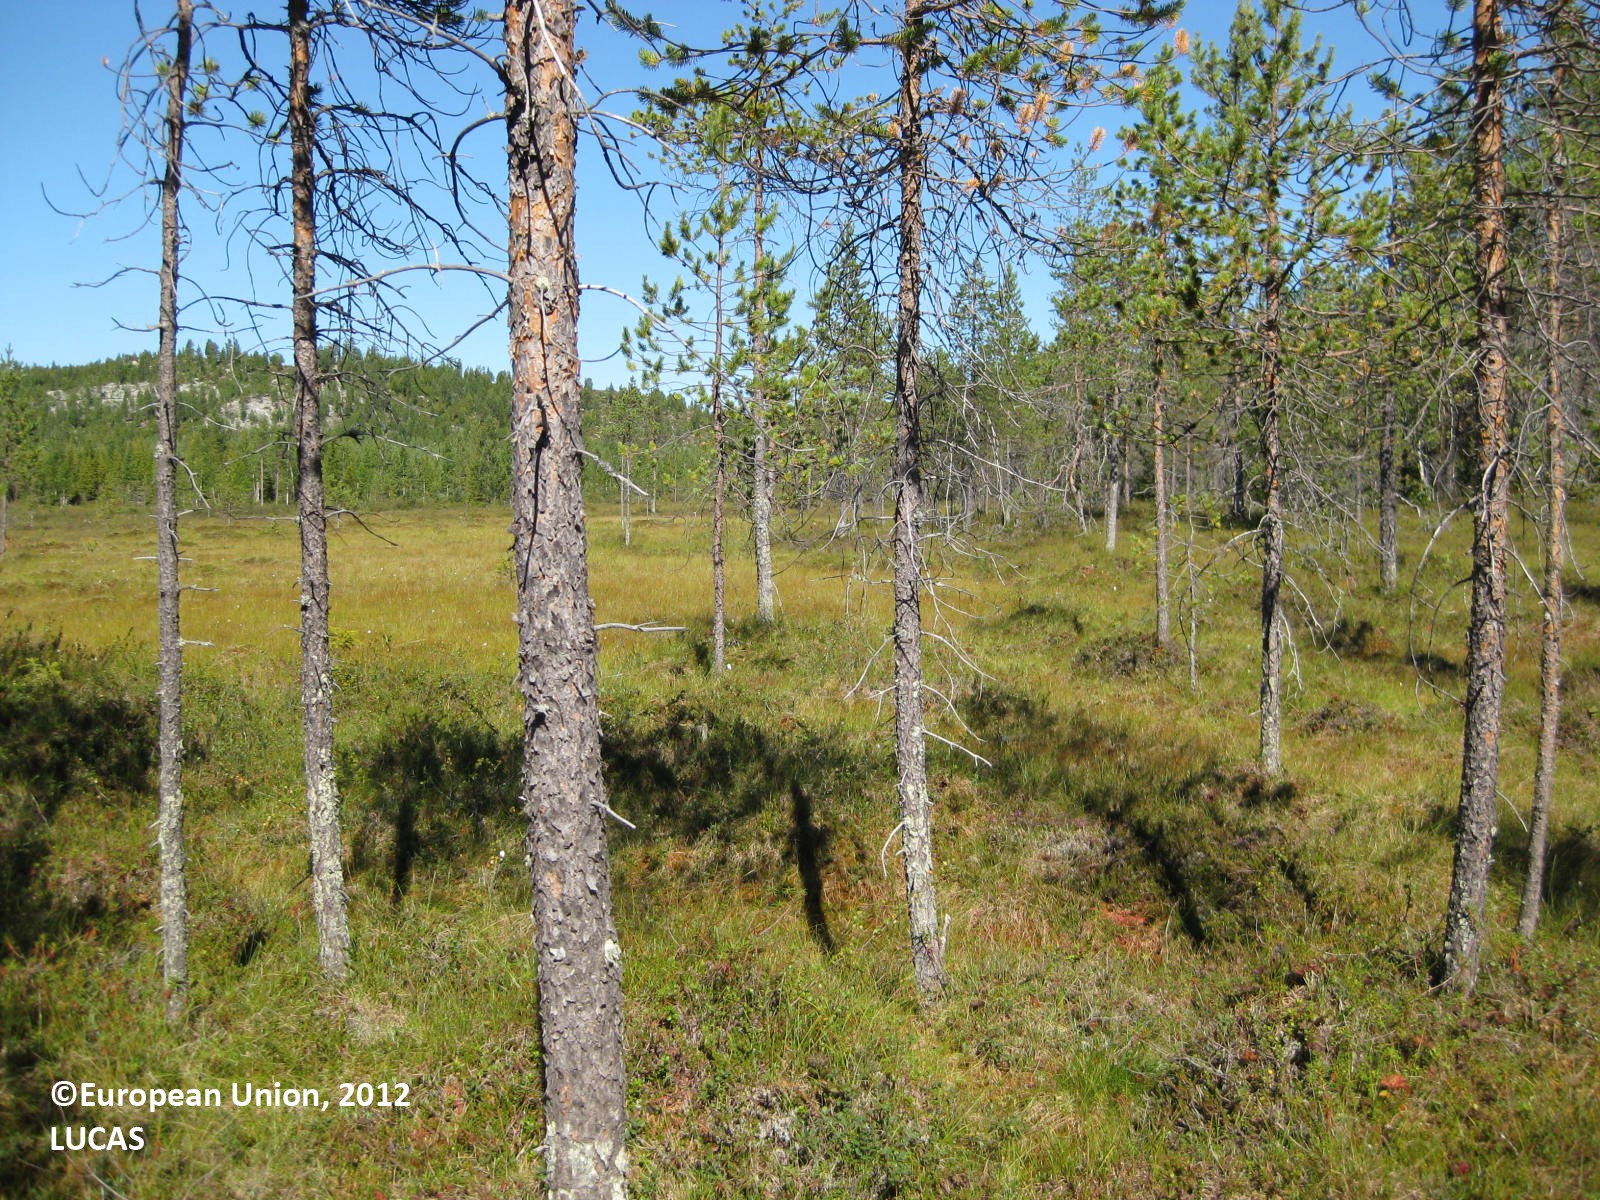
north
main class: Woodland
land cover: Pine dominated coniferous woodland
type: boreal forest
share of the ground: 25 - 50 %
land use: Forestry
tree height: > 5 m
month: August
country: FI
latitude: 66.4311
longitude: 28.5489
